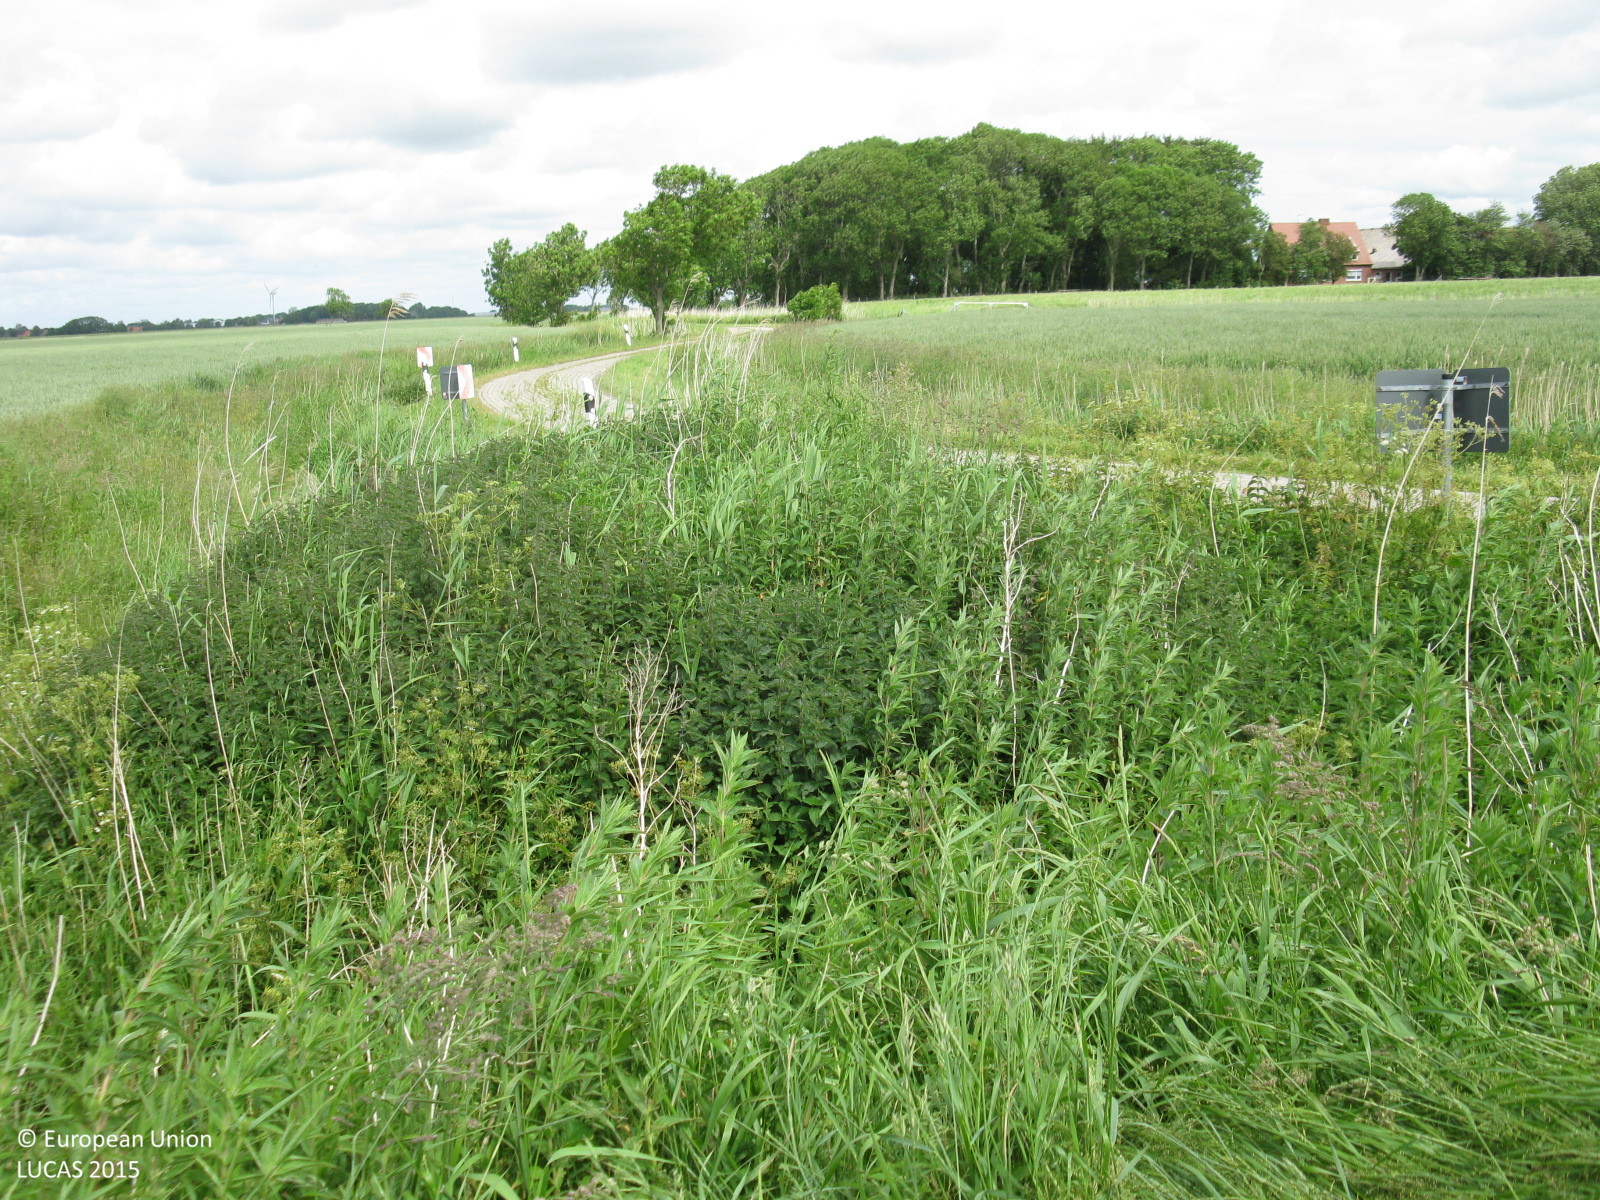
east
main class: Cropland
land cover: Barley
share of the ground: > 75 %
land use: Agriculture (excluding fallow land and kitchen gardens)
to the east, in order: Barley; Grass margins; Ditches and canals; Grass margins; Common wheat
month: June
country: DE
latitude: 53.6601
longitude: 7.3223
